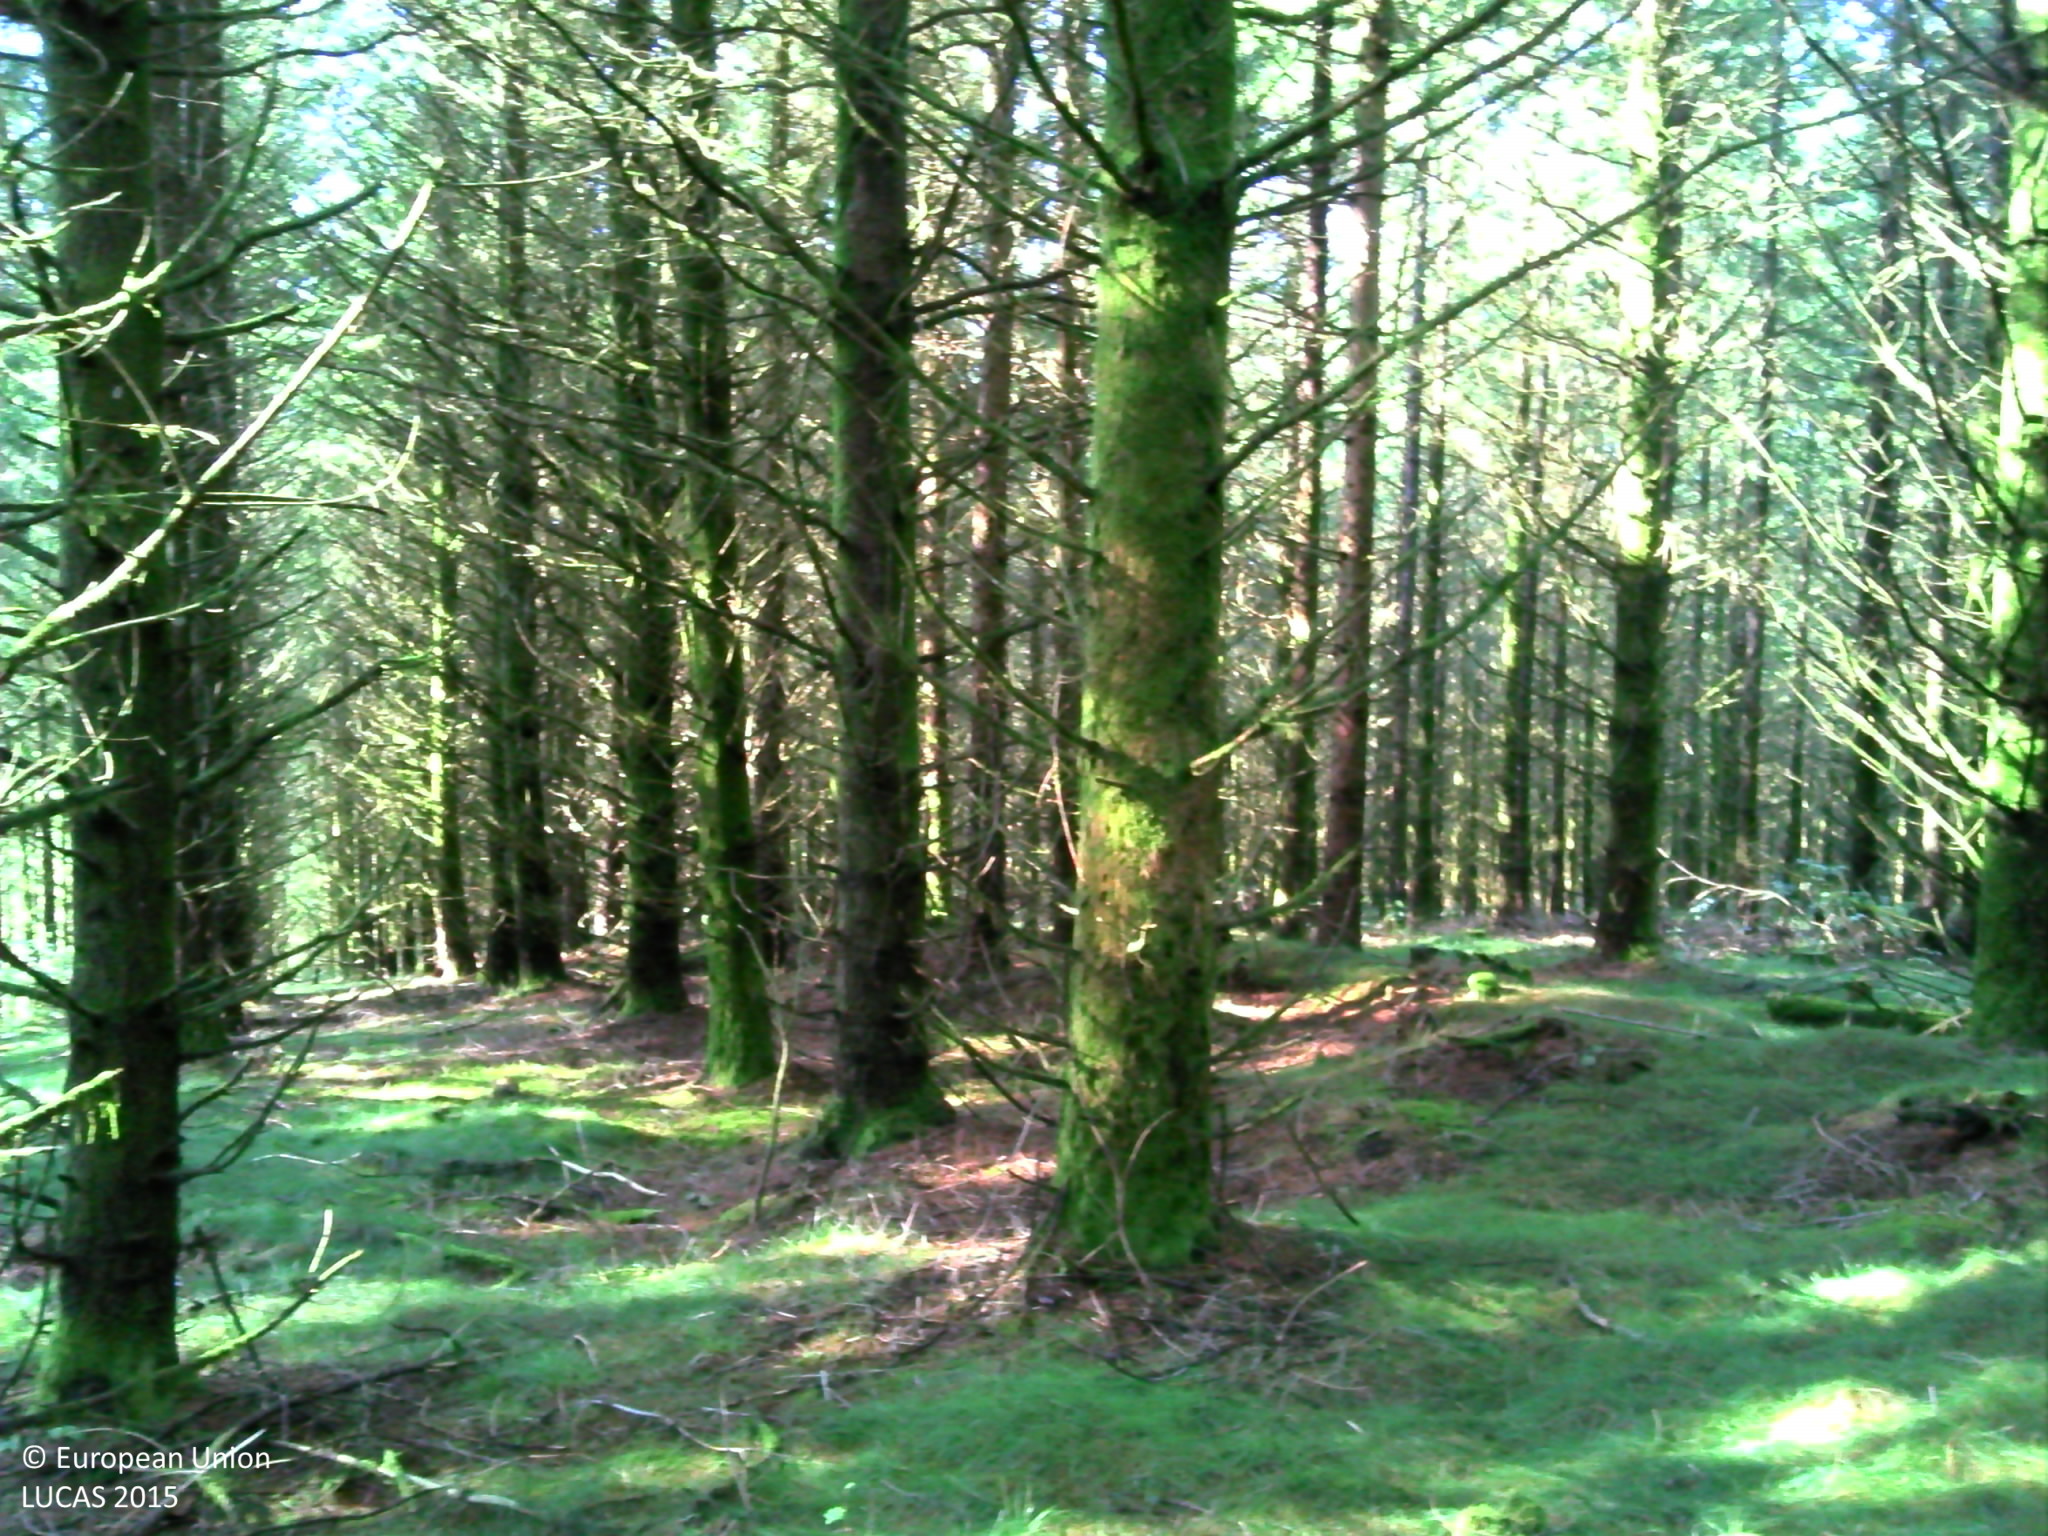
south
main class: Woodland
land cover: Spruce dominated coniferous woodland
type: exotic forest
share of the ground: > 75 %
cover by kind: coniferous forest trees 70 %, herbaceous plants 30 %
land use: Forestry
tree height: > 5 m
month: August
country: FR
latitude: 45.5341
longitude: 1.8640
